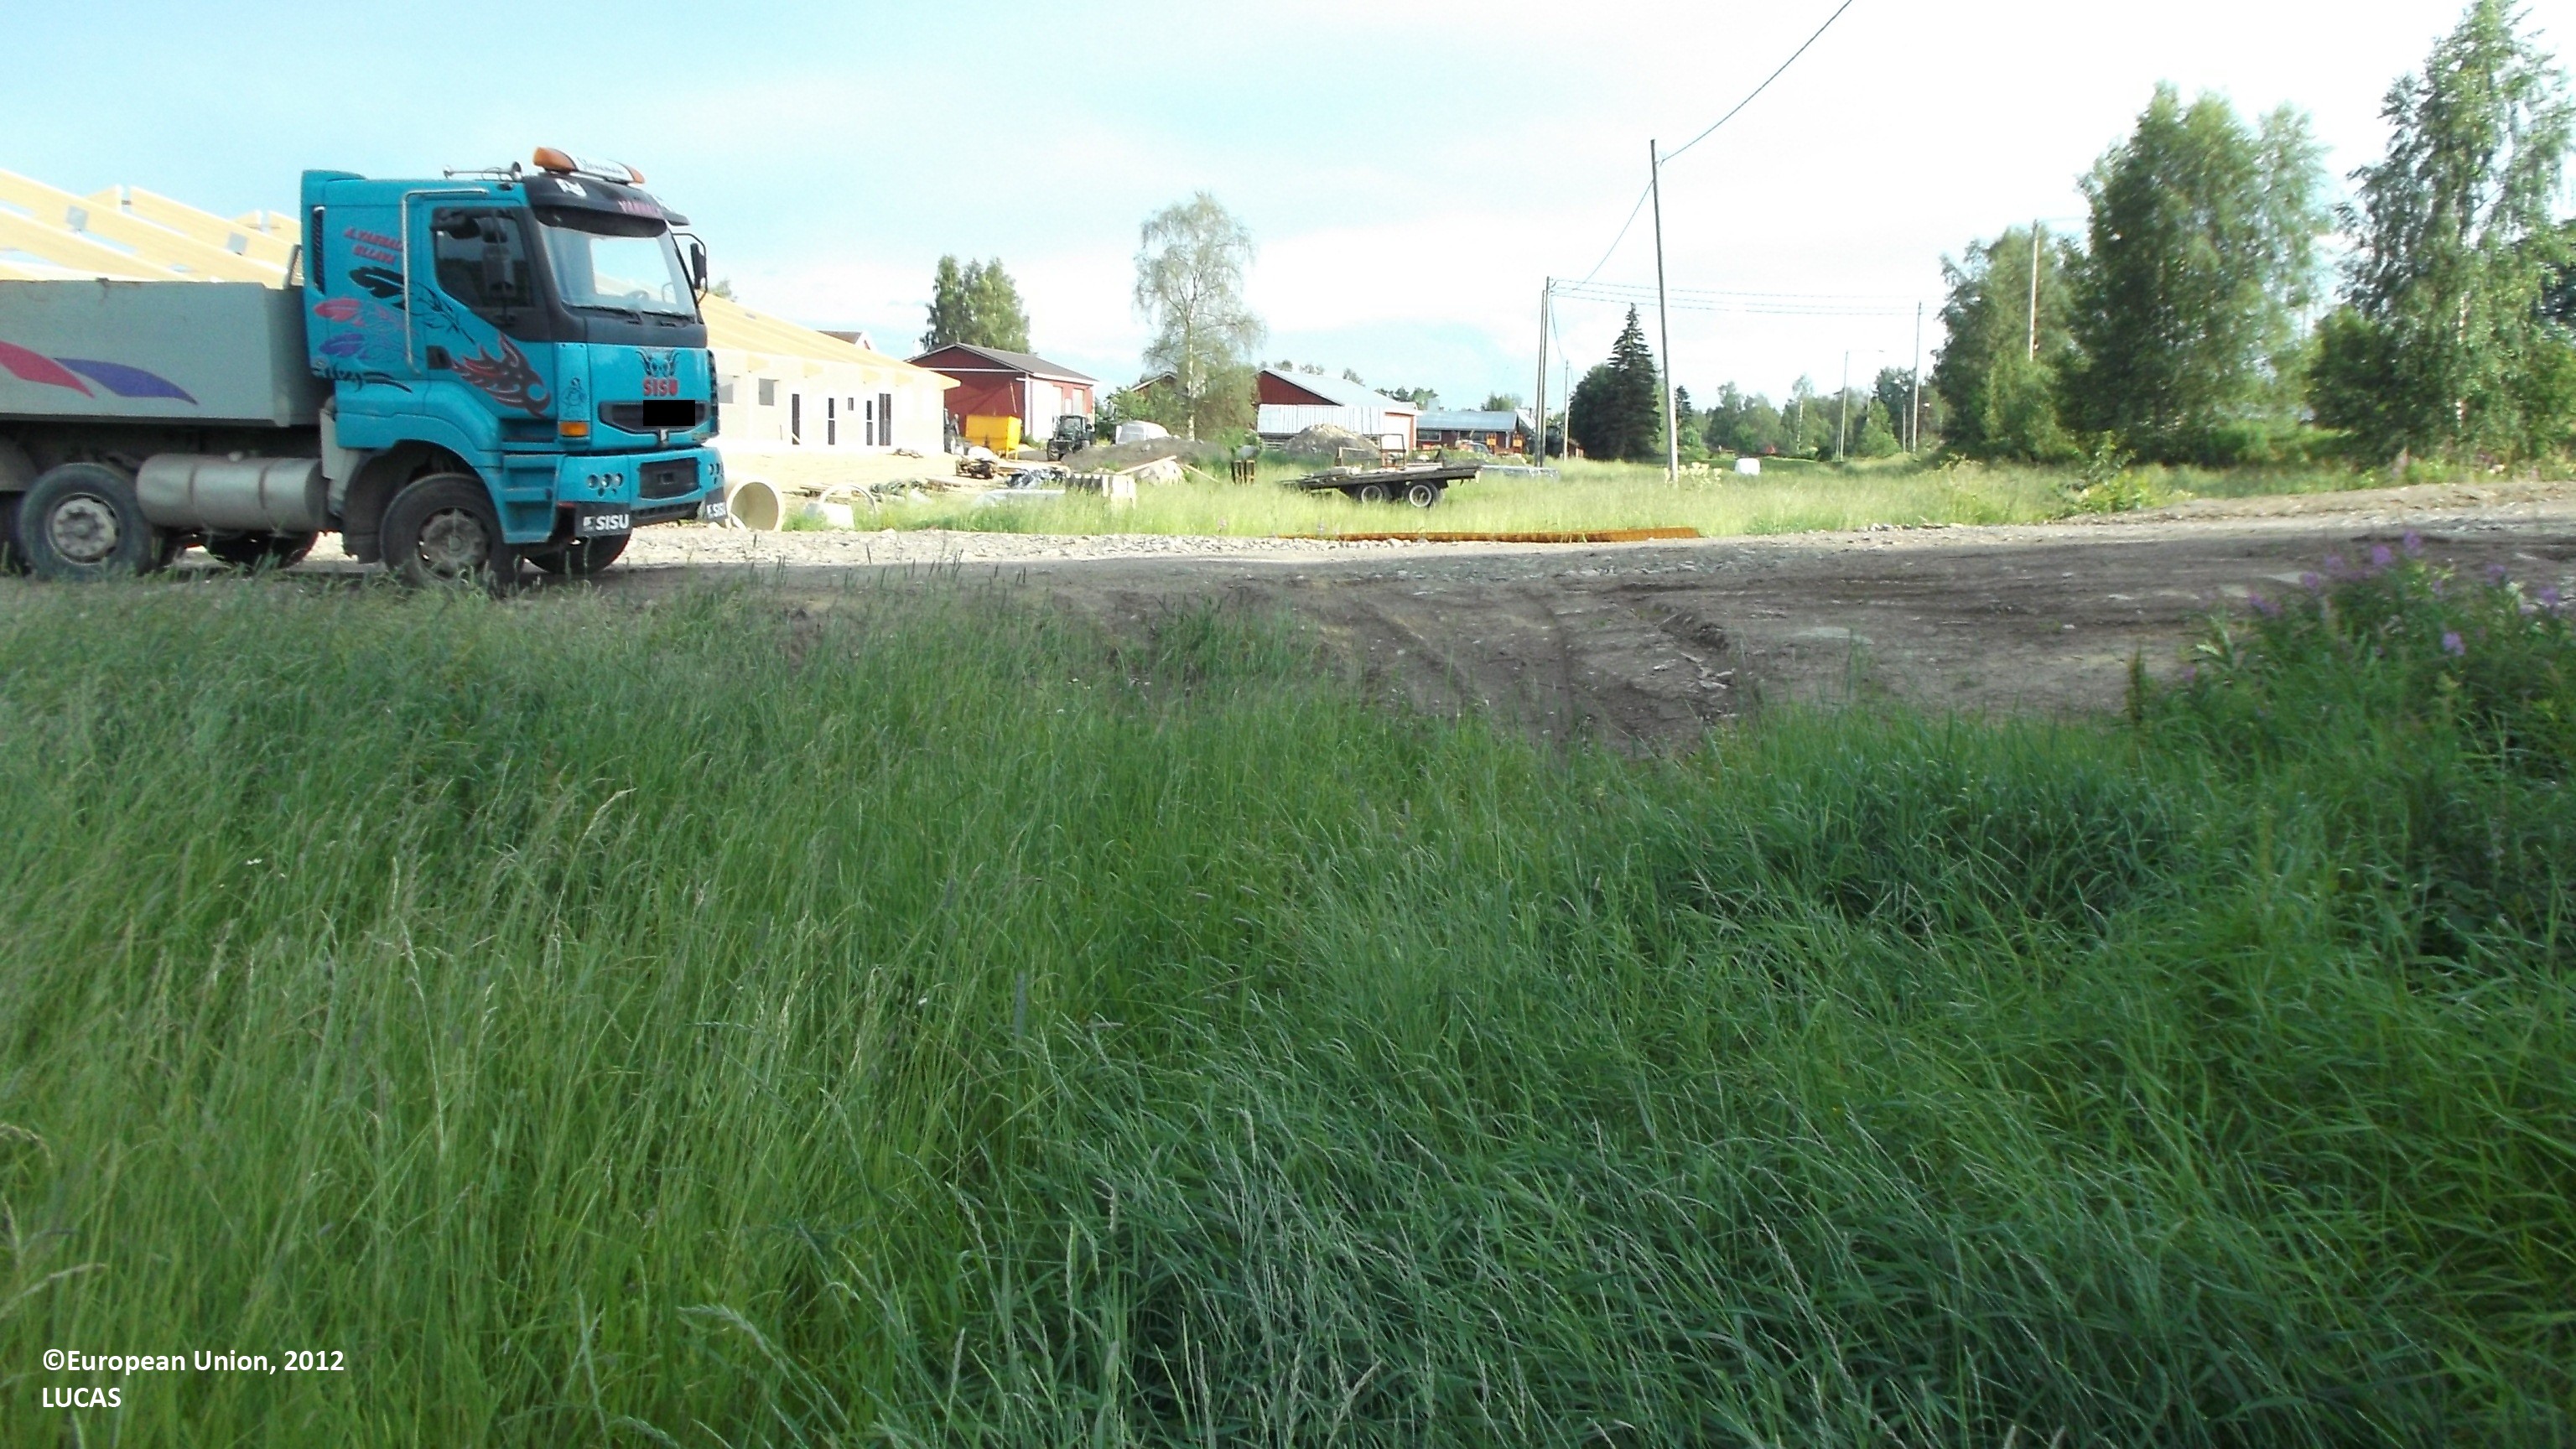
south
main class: Grassland
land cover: Grassland without tree/shrub cover
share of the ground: 50 - 75 %
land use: Fallow land
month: July
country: FI
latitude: 63.6430
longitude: 24.0199
